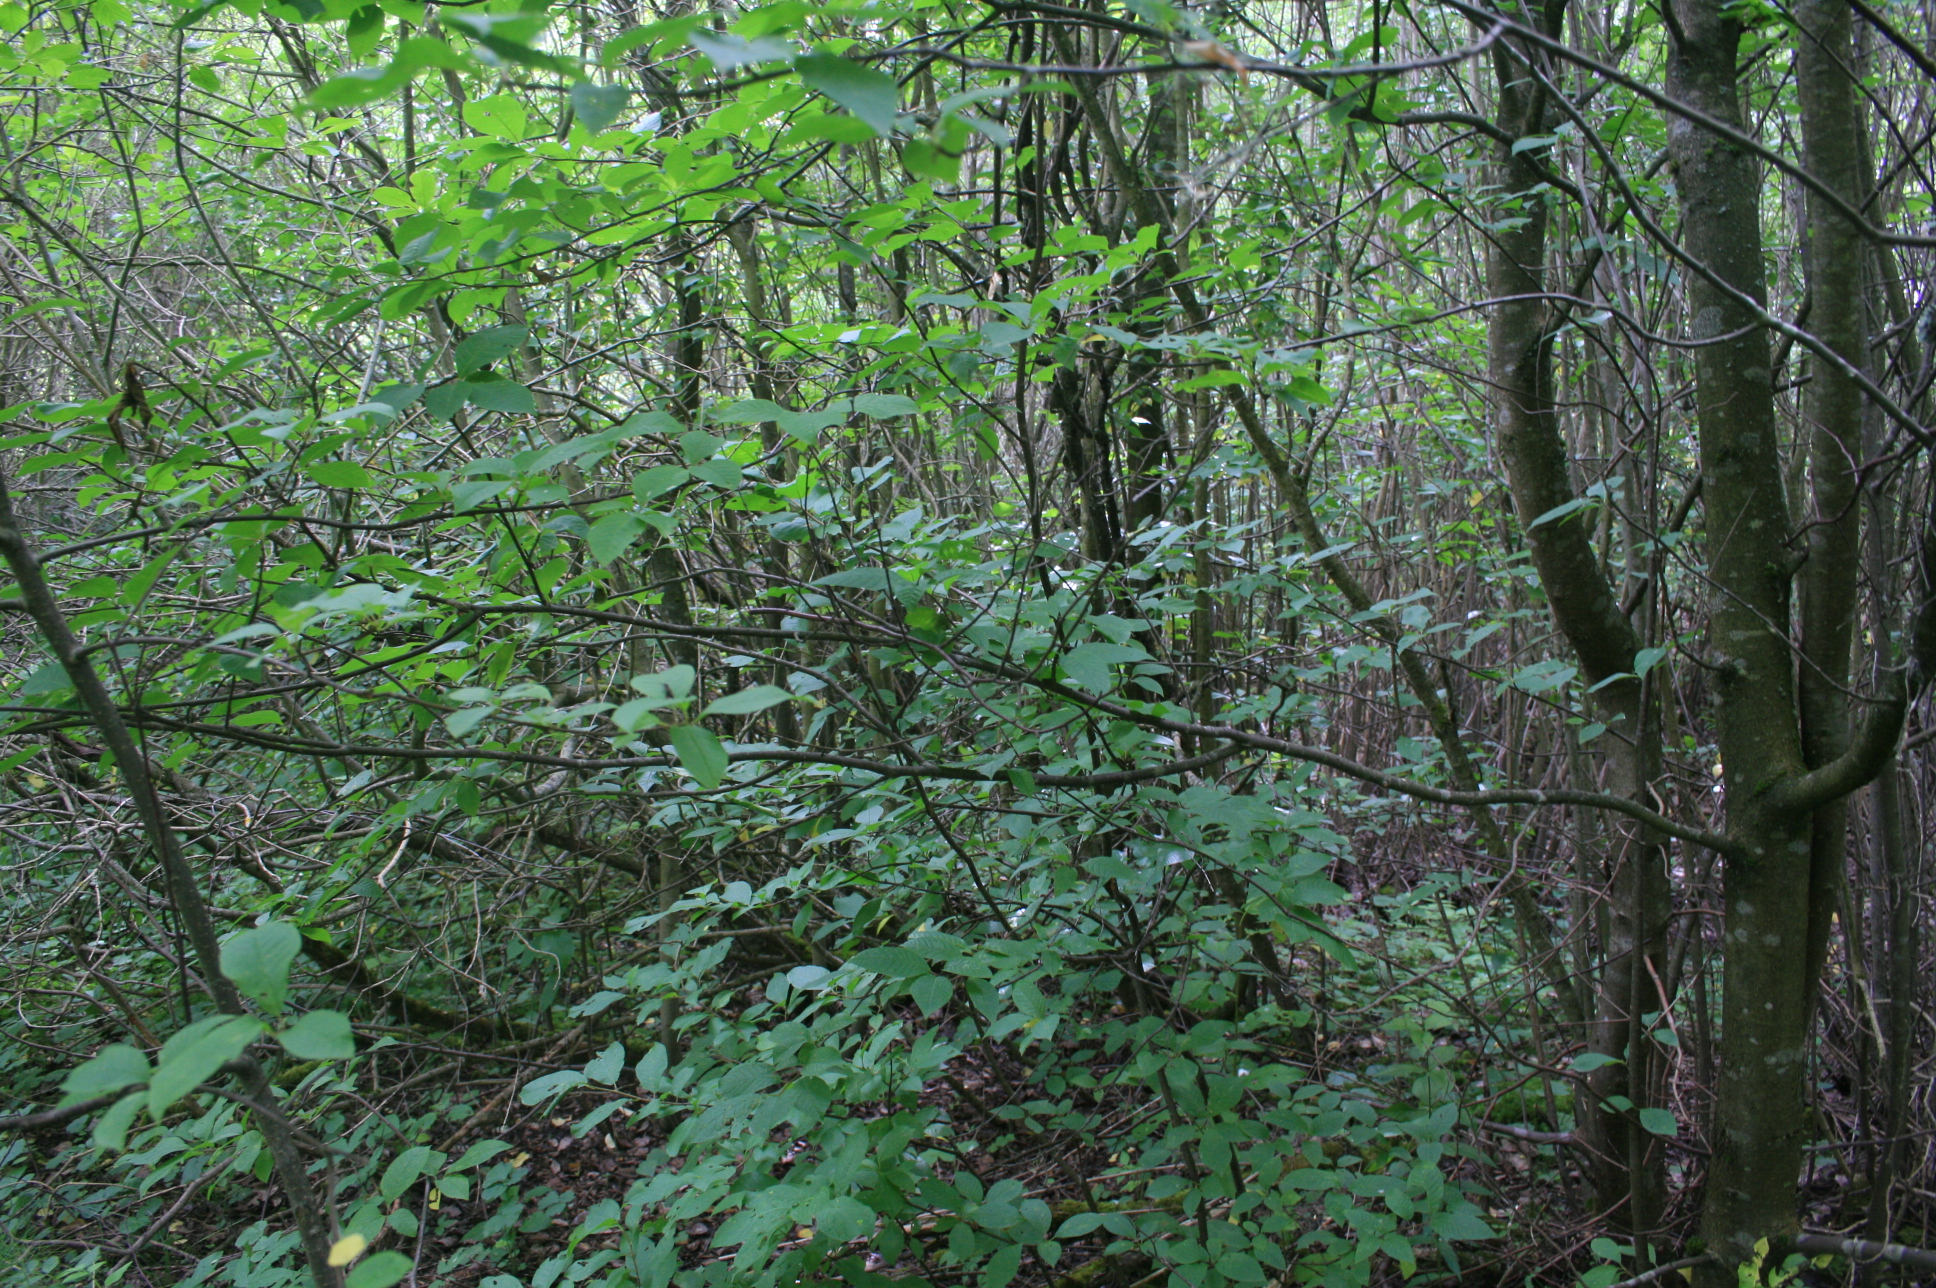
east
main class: Woodland
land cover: Broadleaved woodland
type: non-riverine alder, birch or aspen forest
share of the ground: > 75 %
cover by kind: broadleaved forest trees 95 %, herbaceous plants 5 %
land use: Forestry
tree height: > 5 m
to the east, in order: Broadleaved woodland; Grassland with sparse tree/shrub cover; Broadleaved woodland; Grassland without tree/shrub cover; Broadleaved woodland; Grassland without tree/shrub cover
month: June
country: LT
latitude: 55.2349
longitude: 22.0530
